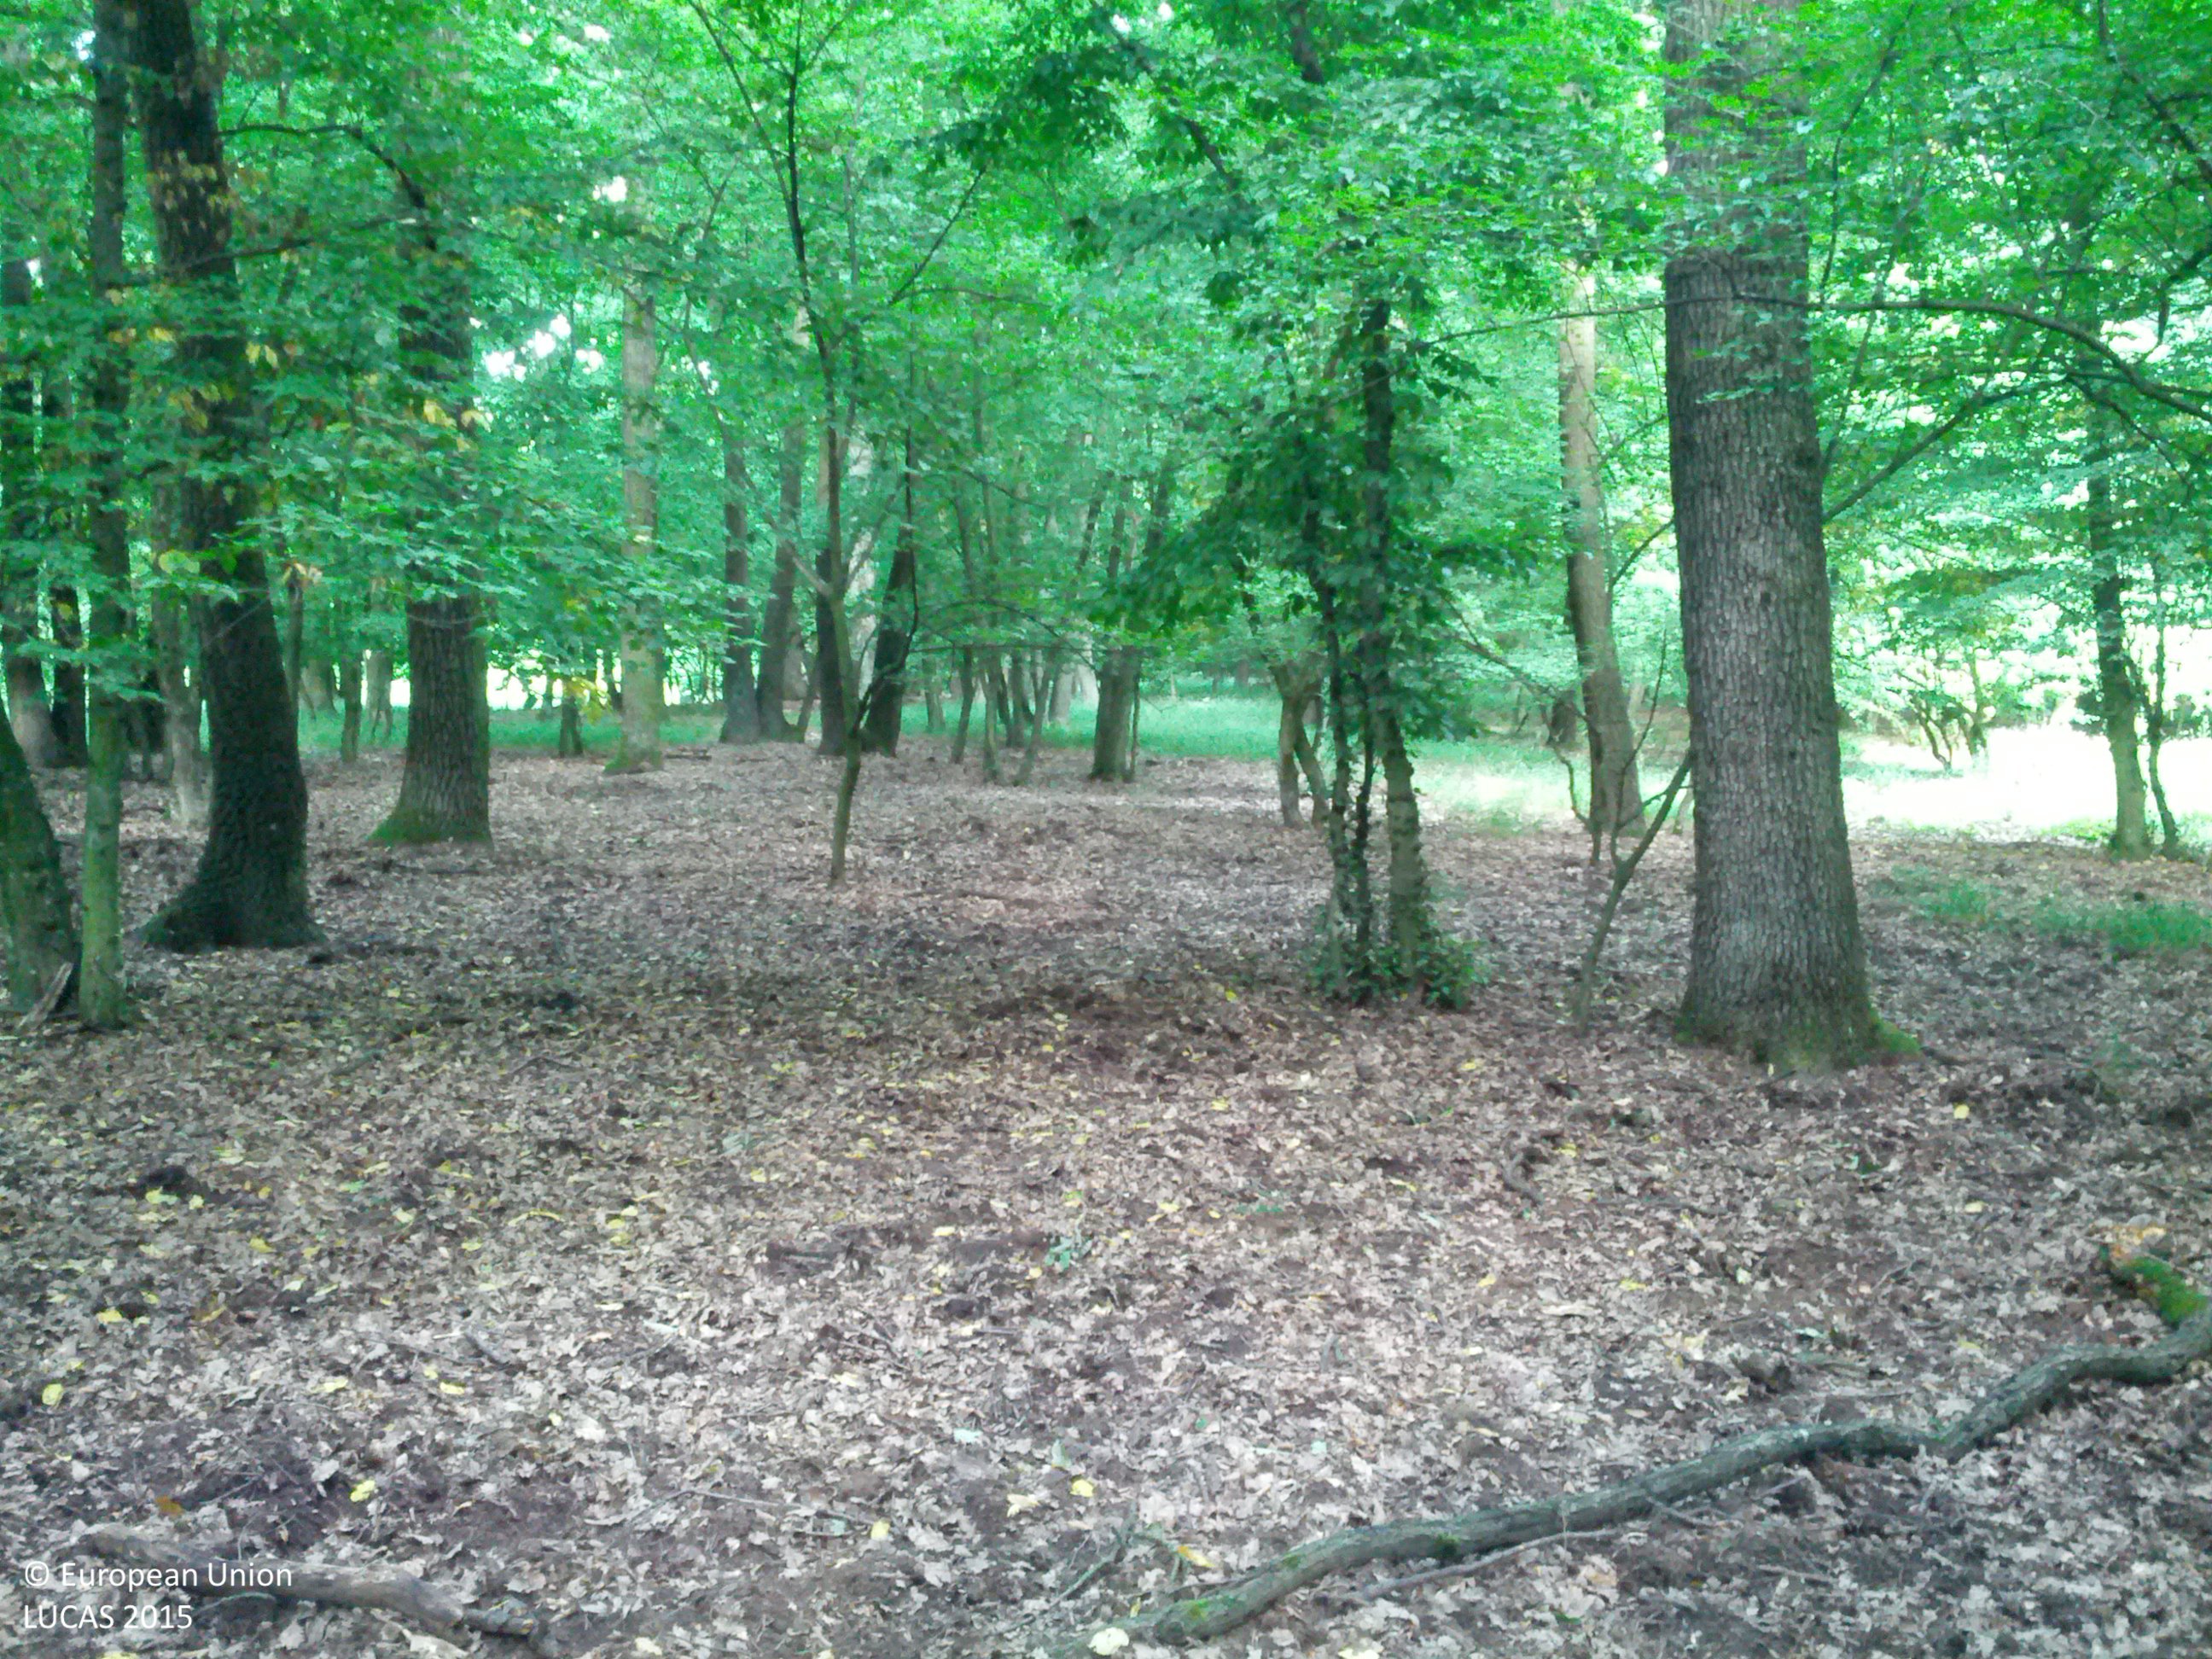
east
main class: Woodland
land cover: Broadleaved woodland
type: beech forest
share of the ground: > 75 %
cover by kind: broadleaved forest trees 90 %, unconsolidated bare surface 10 %
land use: Forestry
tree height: > 5 m
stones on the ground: < 10 %
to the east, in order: Broadleaved woodland; Tracks; Broadleaved woodland
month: June
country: AT
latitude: 48.4236
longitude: 16.5873
